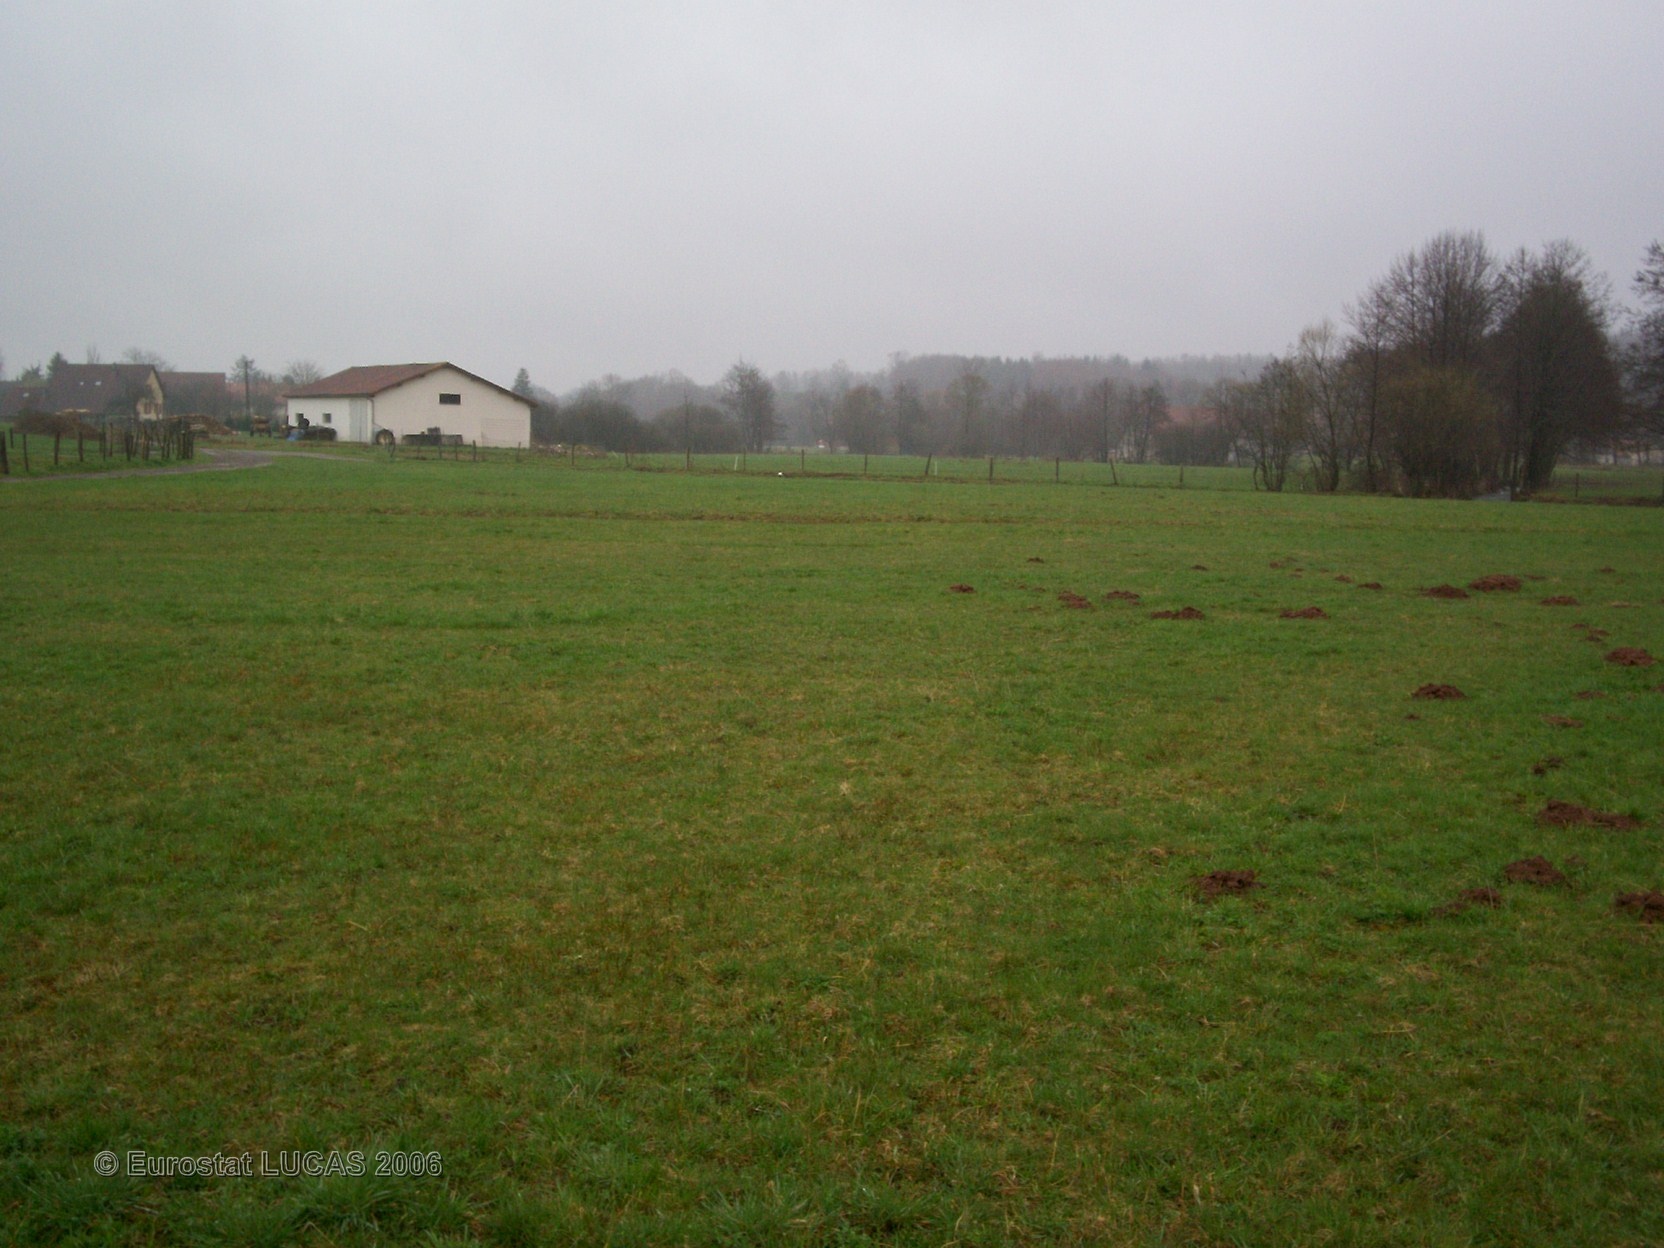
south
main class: Grassland
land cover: Grassland without tree/shrub cover
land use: Agriculture (excluding fallow land and kitchen gardens)
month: April
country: FR
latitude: 47.7093
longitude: 6.8160
